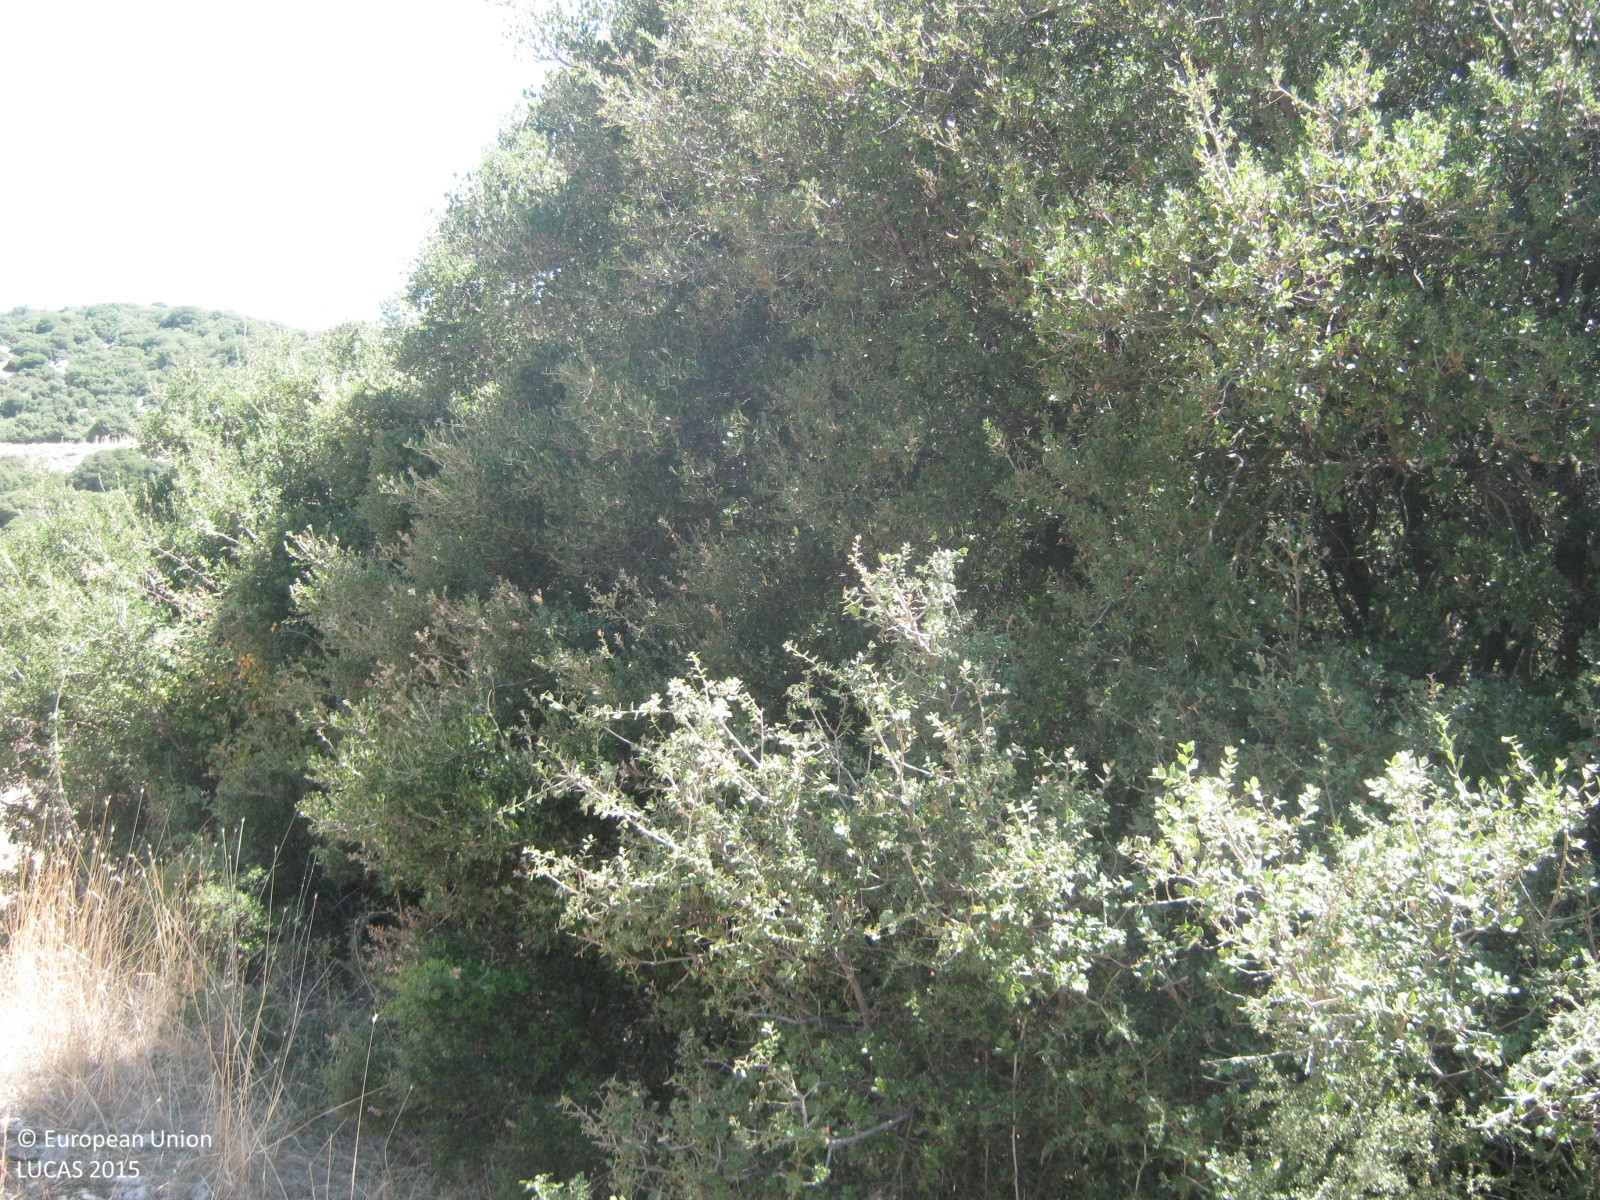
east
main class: Shrubland
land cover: Shrubland with sparse tree cover
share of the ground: > 75 %
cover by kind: shrubs 85 %, herbaceous plants 10 %, broadleaved forest trees 5 %
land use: Semi-natural and natural areas not in use
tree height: > 5 m
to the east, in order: Shrubland with sparse tree cover; Spontaneously vegetated surfaces; Electric lines; Shrubland with sparse tree cover; Ditches and canals; Broadleaved woodland; Spontaneously vegetated surfaces; Electric lines; Spontaneously vegetated surfaces; Shrubland without tree cover; Grassland with sparse tree/shrub cover; Fences; Shrubland without tree cover; Grassland with sparse tree/shrub cover
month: September
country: GR
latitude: 37.8406
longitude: 21.7462
